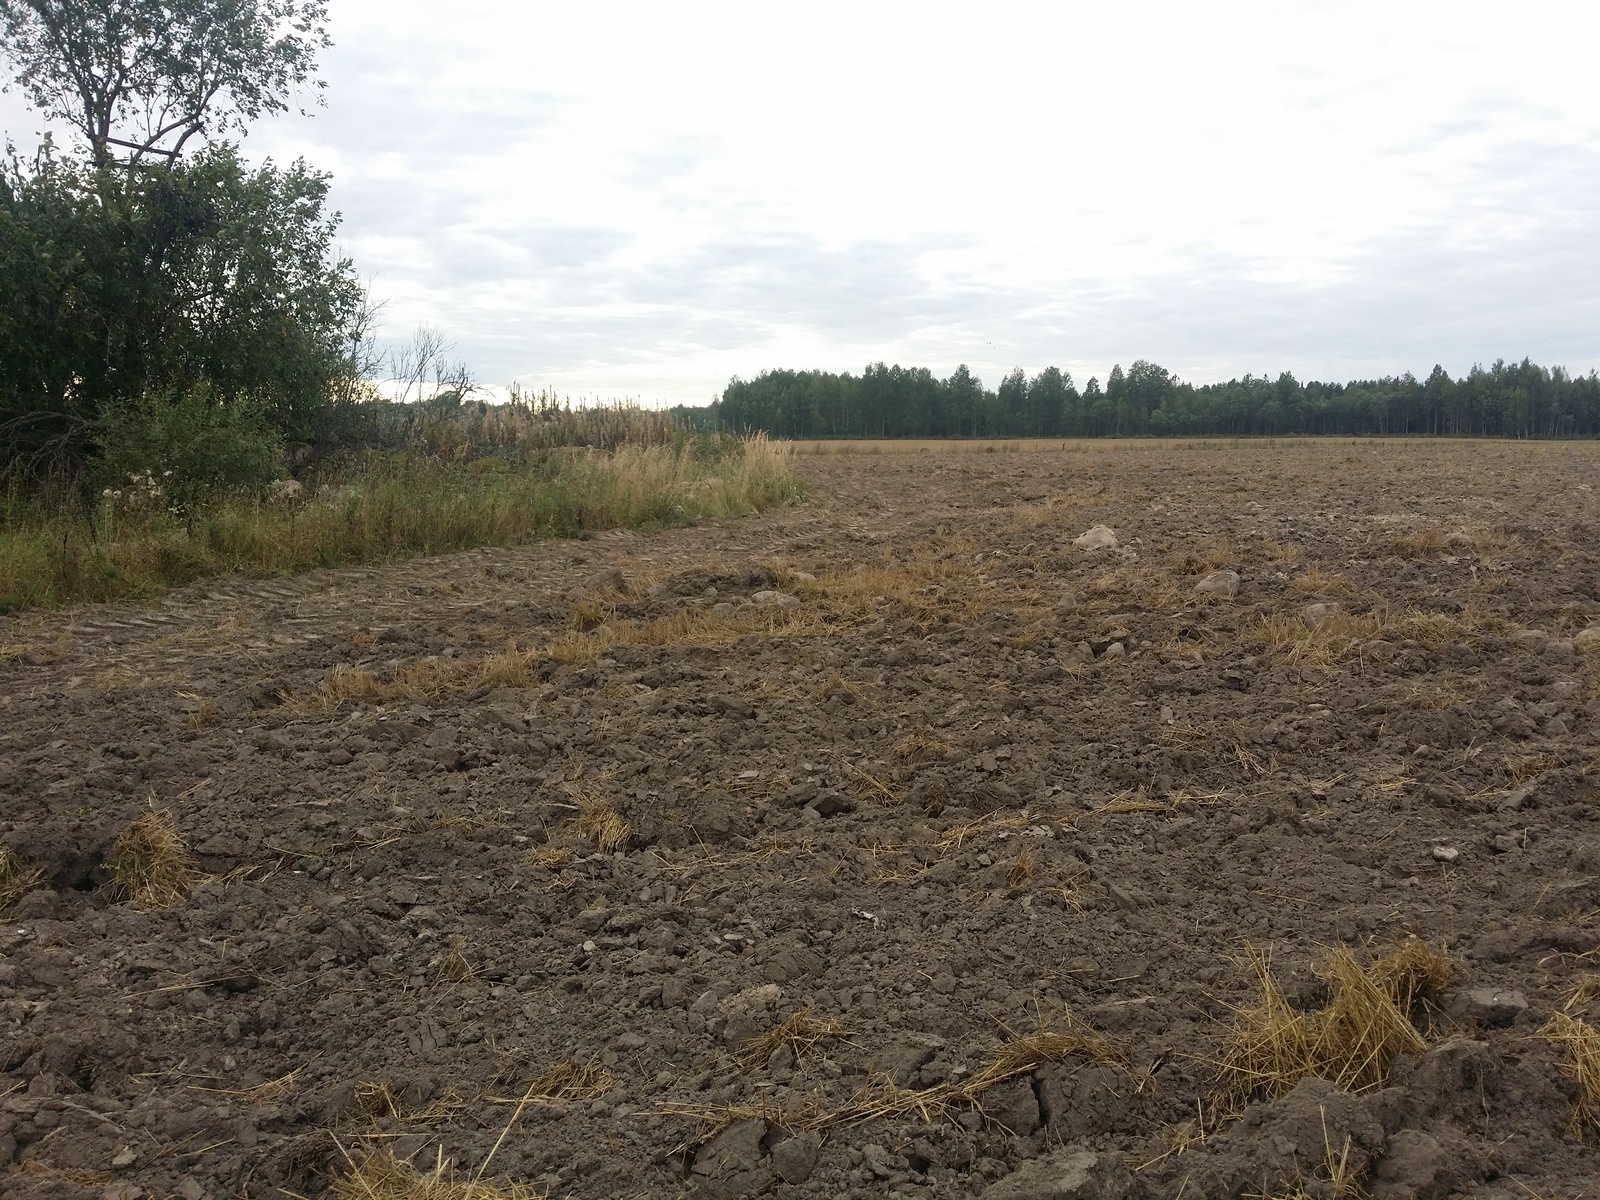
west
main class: Cropland
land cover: Common wheat
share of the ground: < 10 %
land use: Agriculture (excluding fallow land and kitchen gardens)
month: September
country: LV
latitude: 57.0167
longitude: 27.1117
